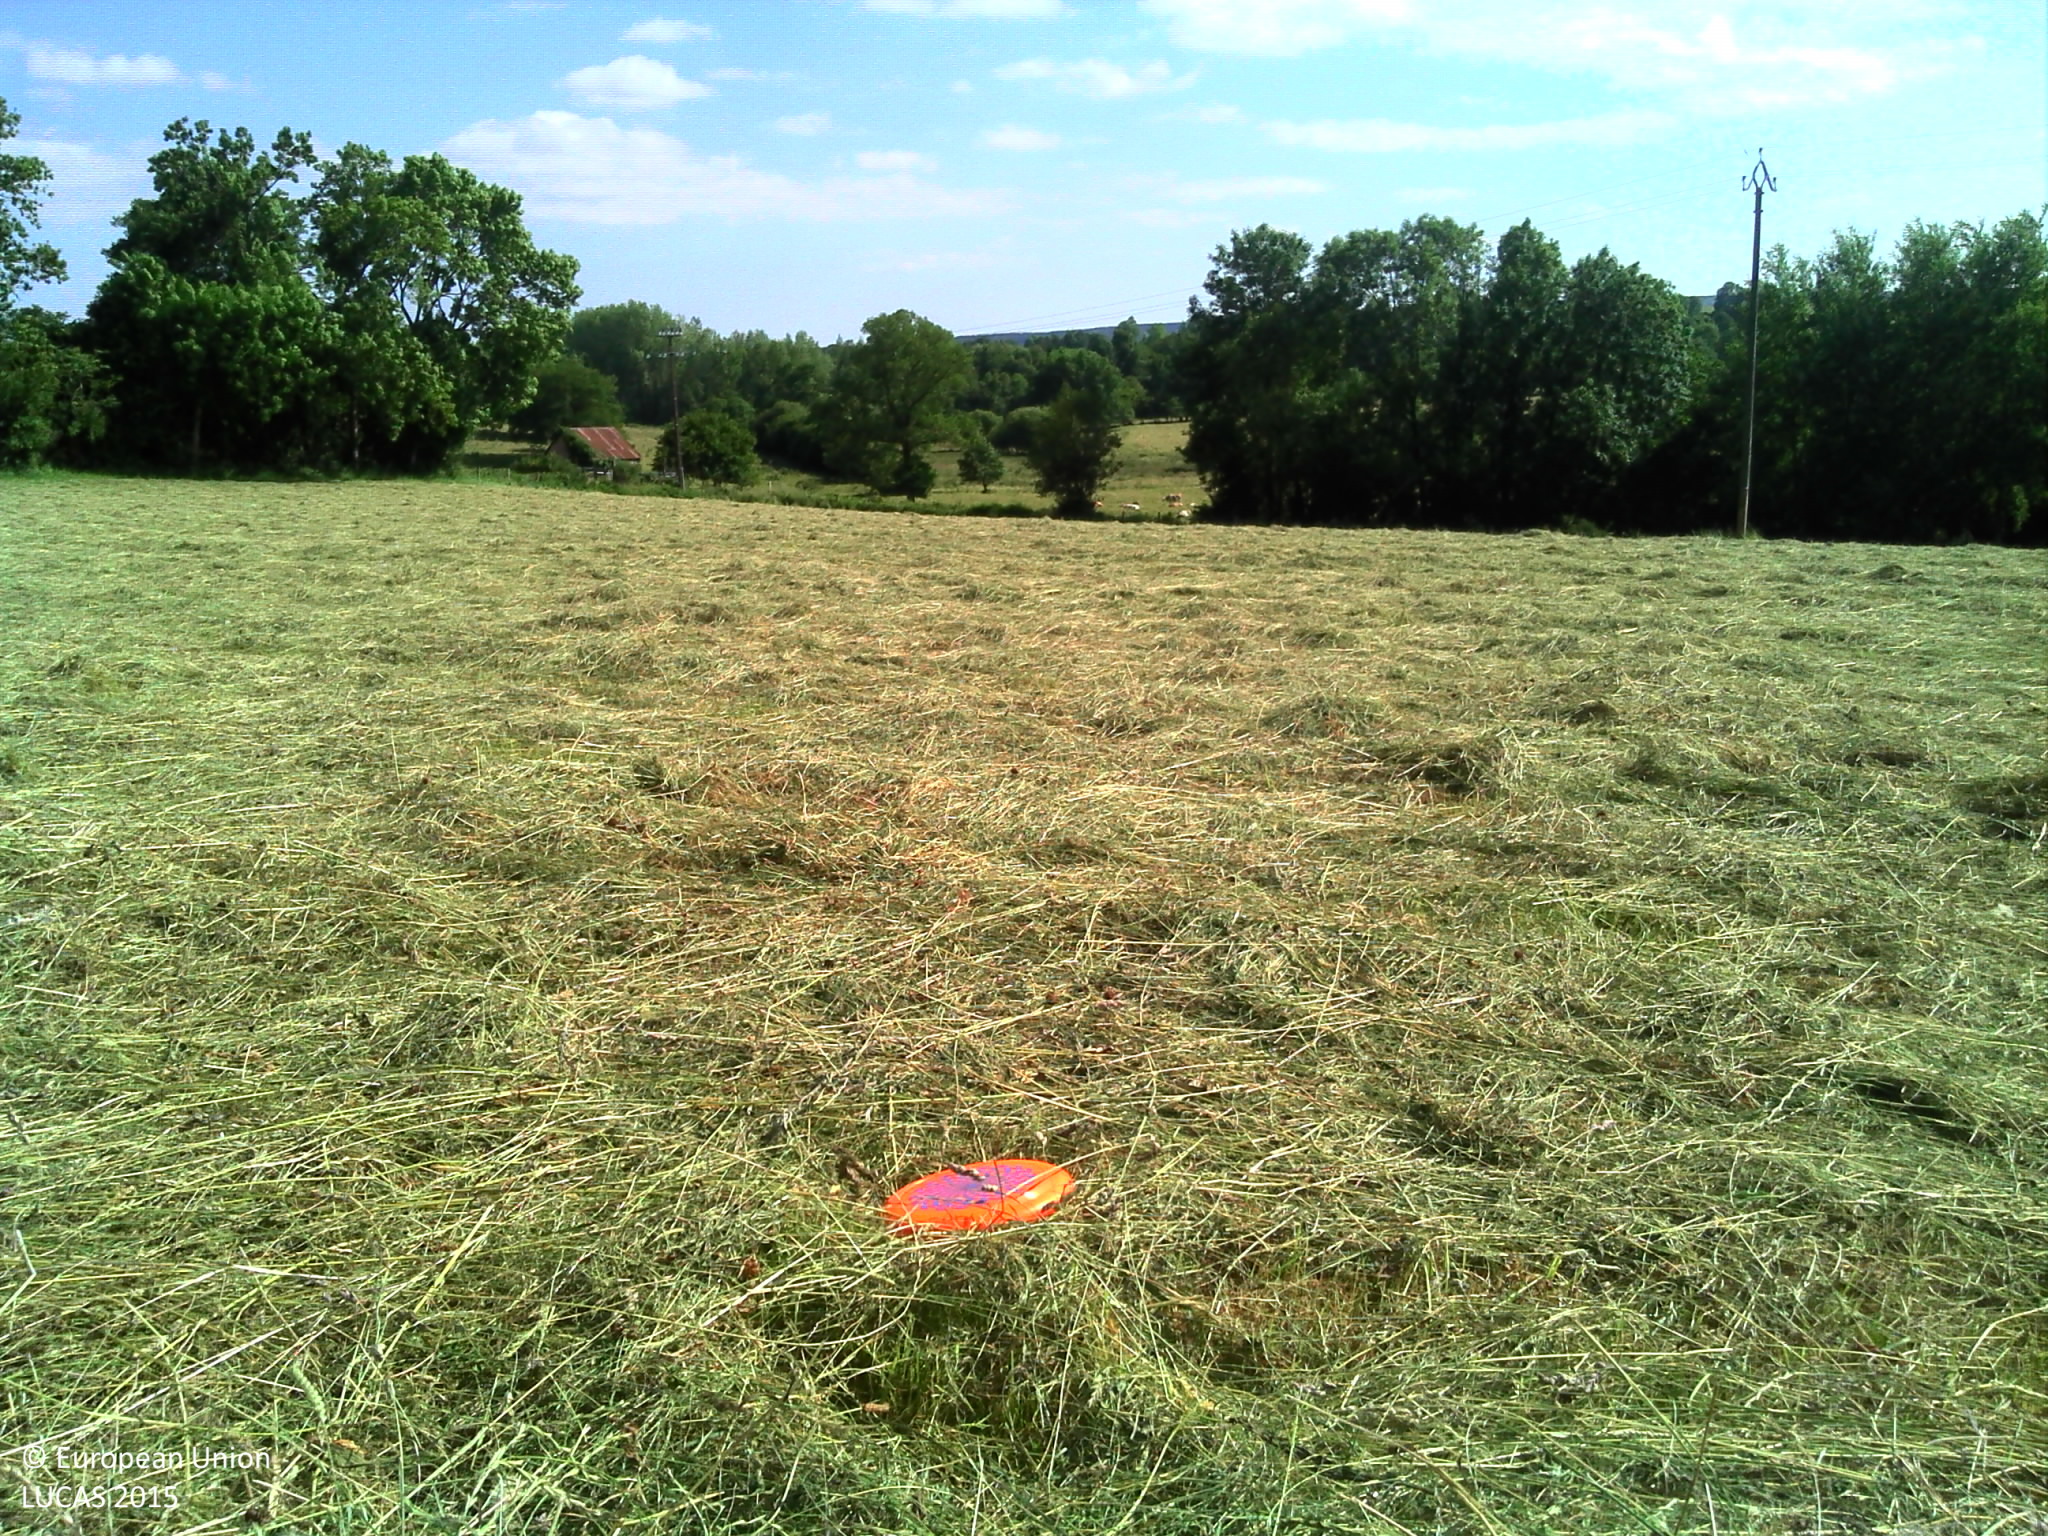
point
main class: Grassland
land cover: Grassland without tree/shrub cover
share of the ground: > 75 %
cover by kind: herbaceous plants 100 %
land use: Agriculture (excluding fallow land and kitchen gardens)
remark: Harvested field
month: June
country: FR
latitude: 48.5007
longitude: -0.1135
